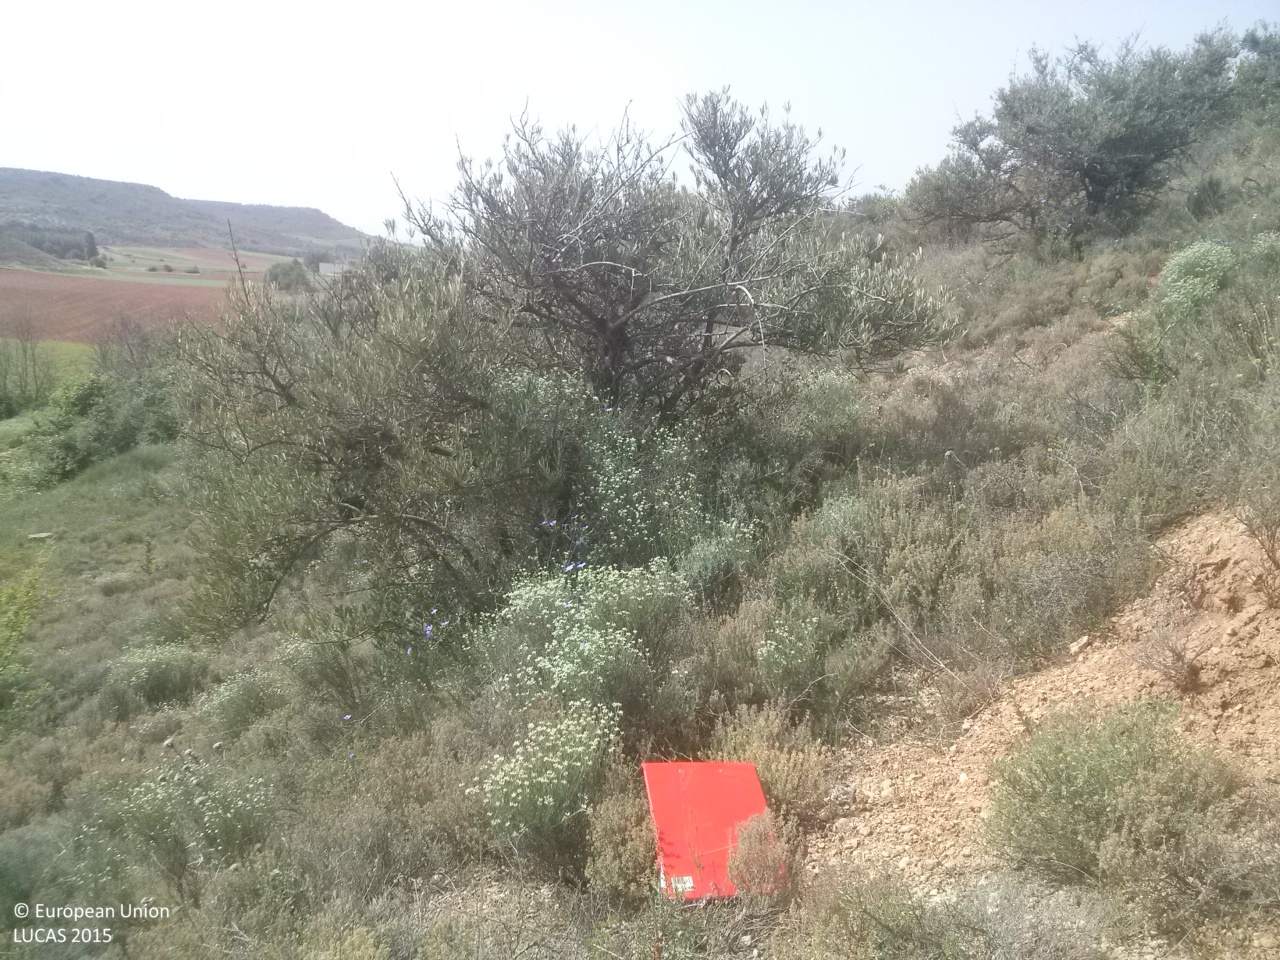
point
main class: Cropland
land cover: Olive groves
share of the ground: 10 - 25 %
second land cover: Shrubland without tree cover
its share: > 75 %
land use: Abandoned areas
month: May
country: ES
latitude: 39.9720
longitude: -2.5347
